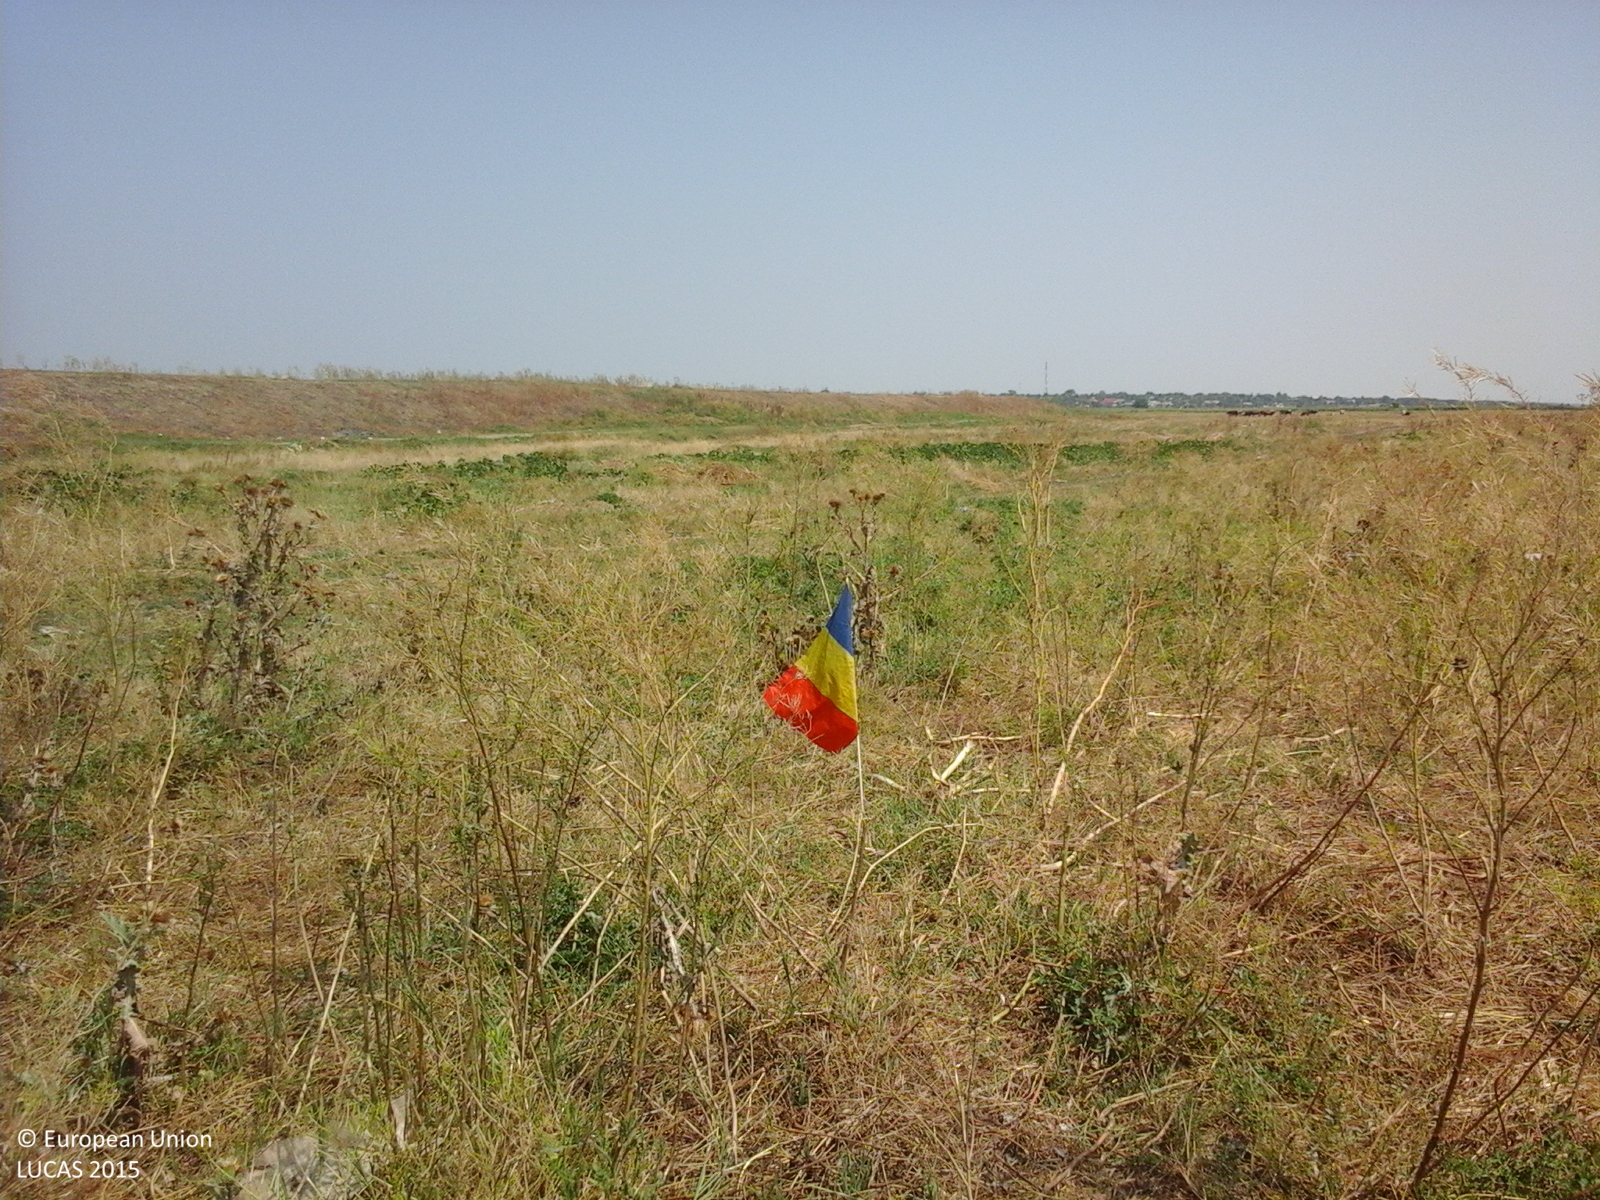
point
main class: Grassland
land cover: Spontaneously vegetated surfaces
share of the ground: > 75 %
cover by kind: herbaceous plants 100 %
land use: Fallow land
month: July
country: RO
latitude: 45.4558
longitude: 27.7699
